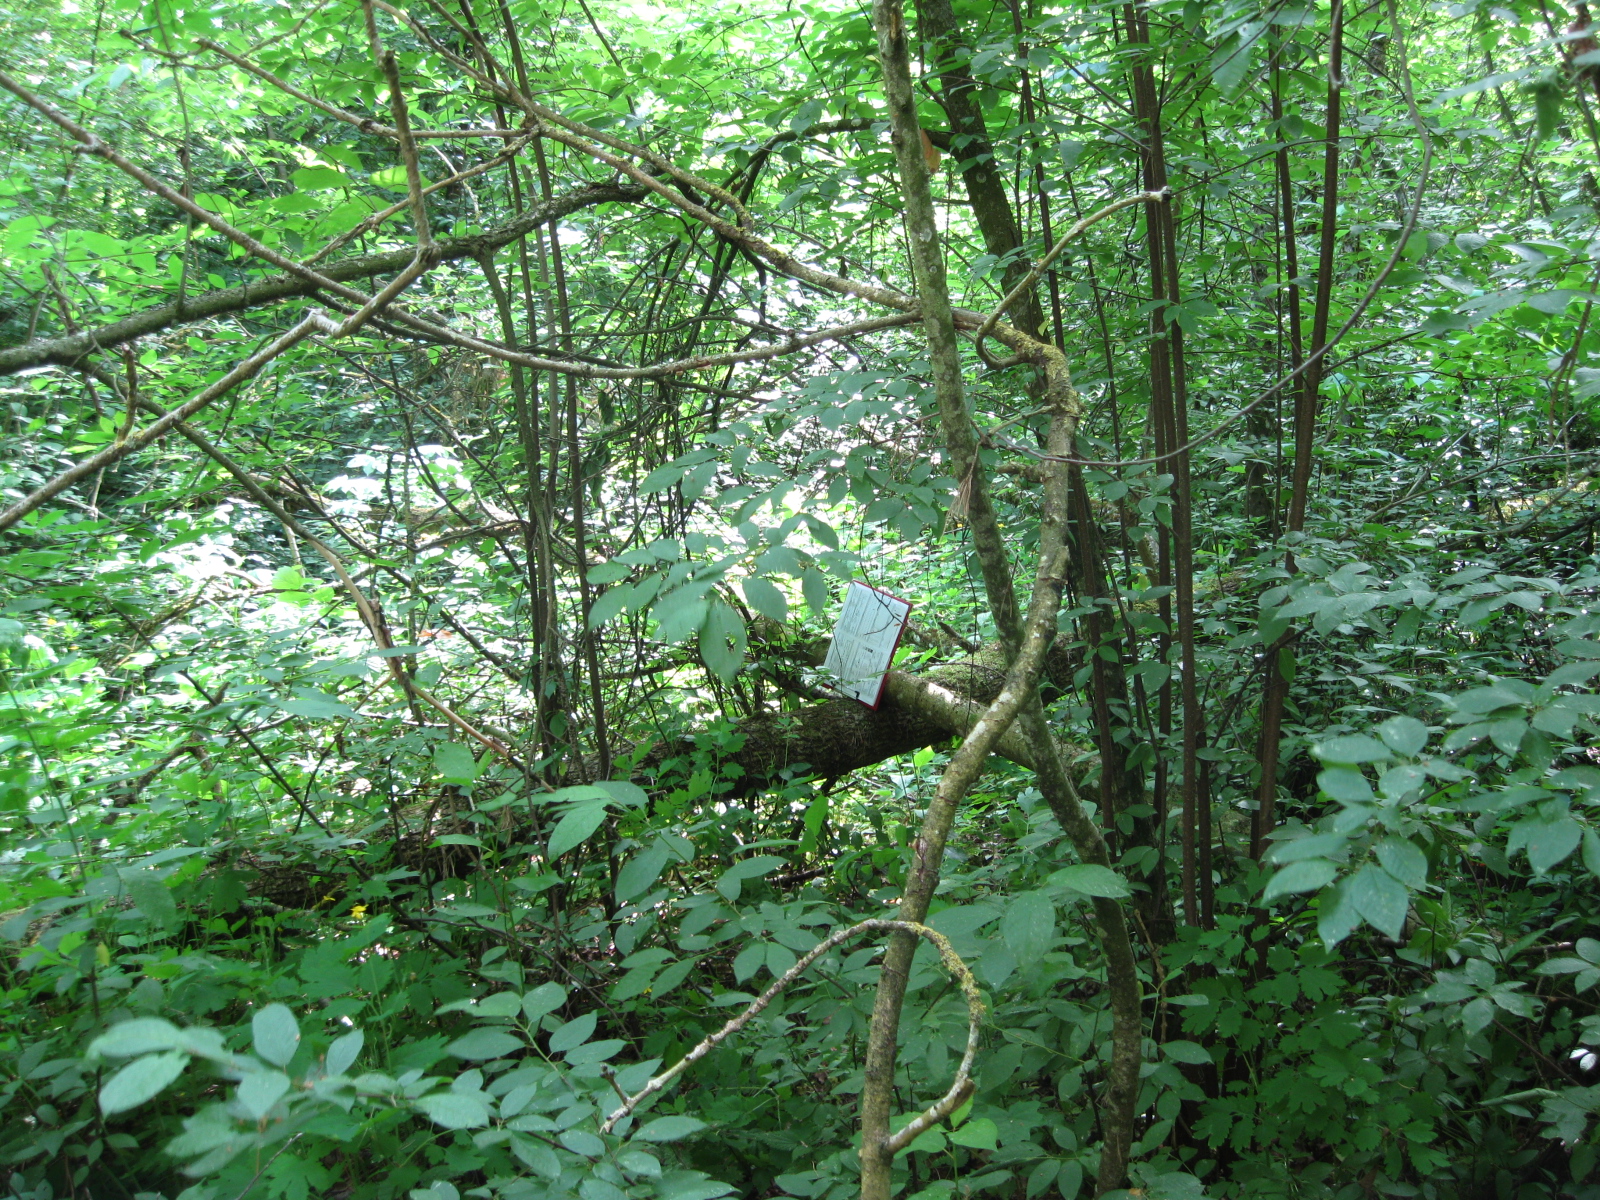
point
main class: Woodland
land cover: Pine dominated mixed woodland
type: hemiboreal forest and nemoral coniferous forest and mixed broadleaved-coniferous forest
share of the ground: > 75 %
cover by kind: broadleaved forest trees 45 %, coniferous forest trees 40 %, herbaceous plants 10 %, shrubs 5 %
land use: Forestry
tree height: > 5 m
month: June
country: LT
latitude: 55.7443
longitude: 23.8320
